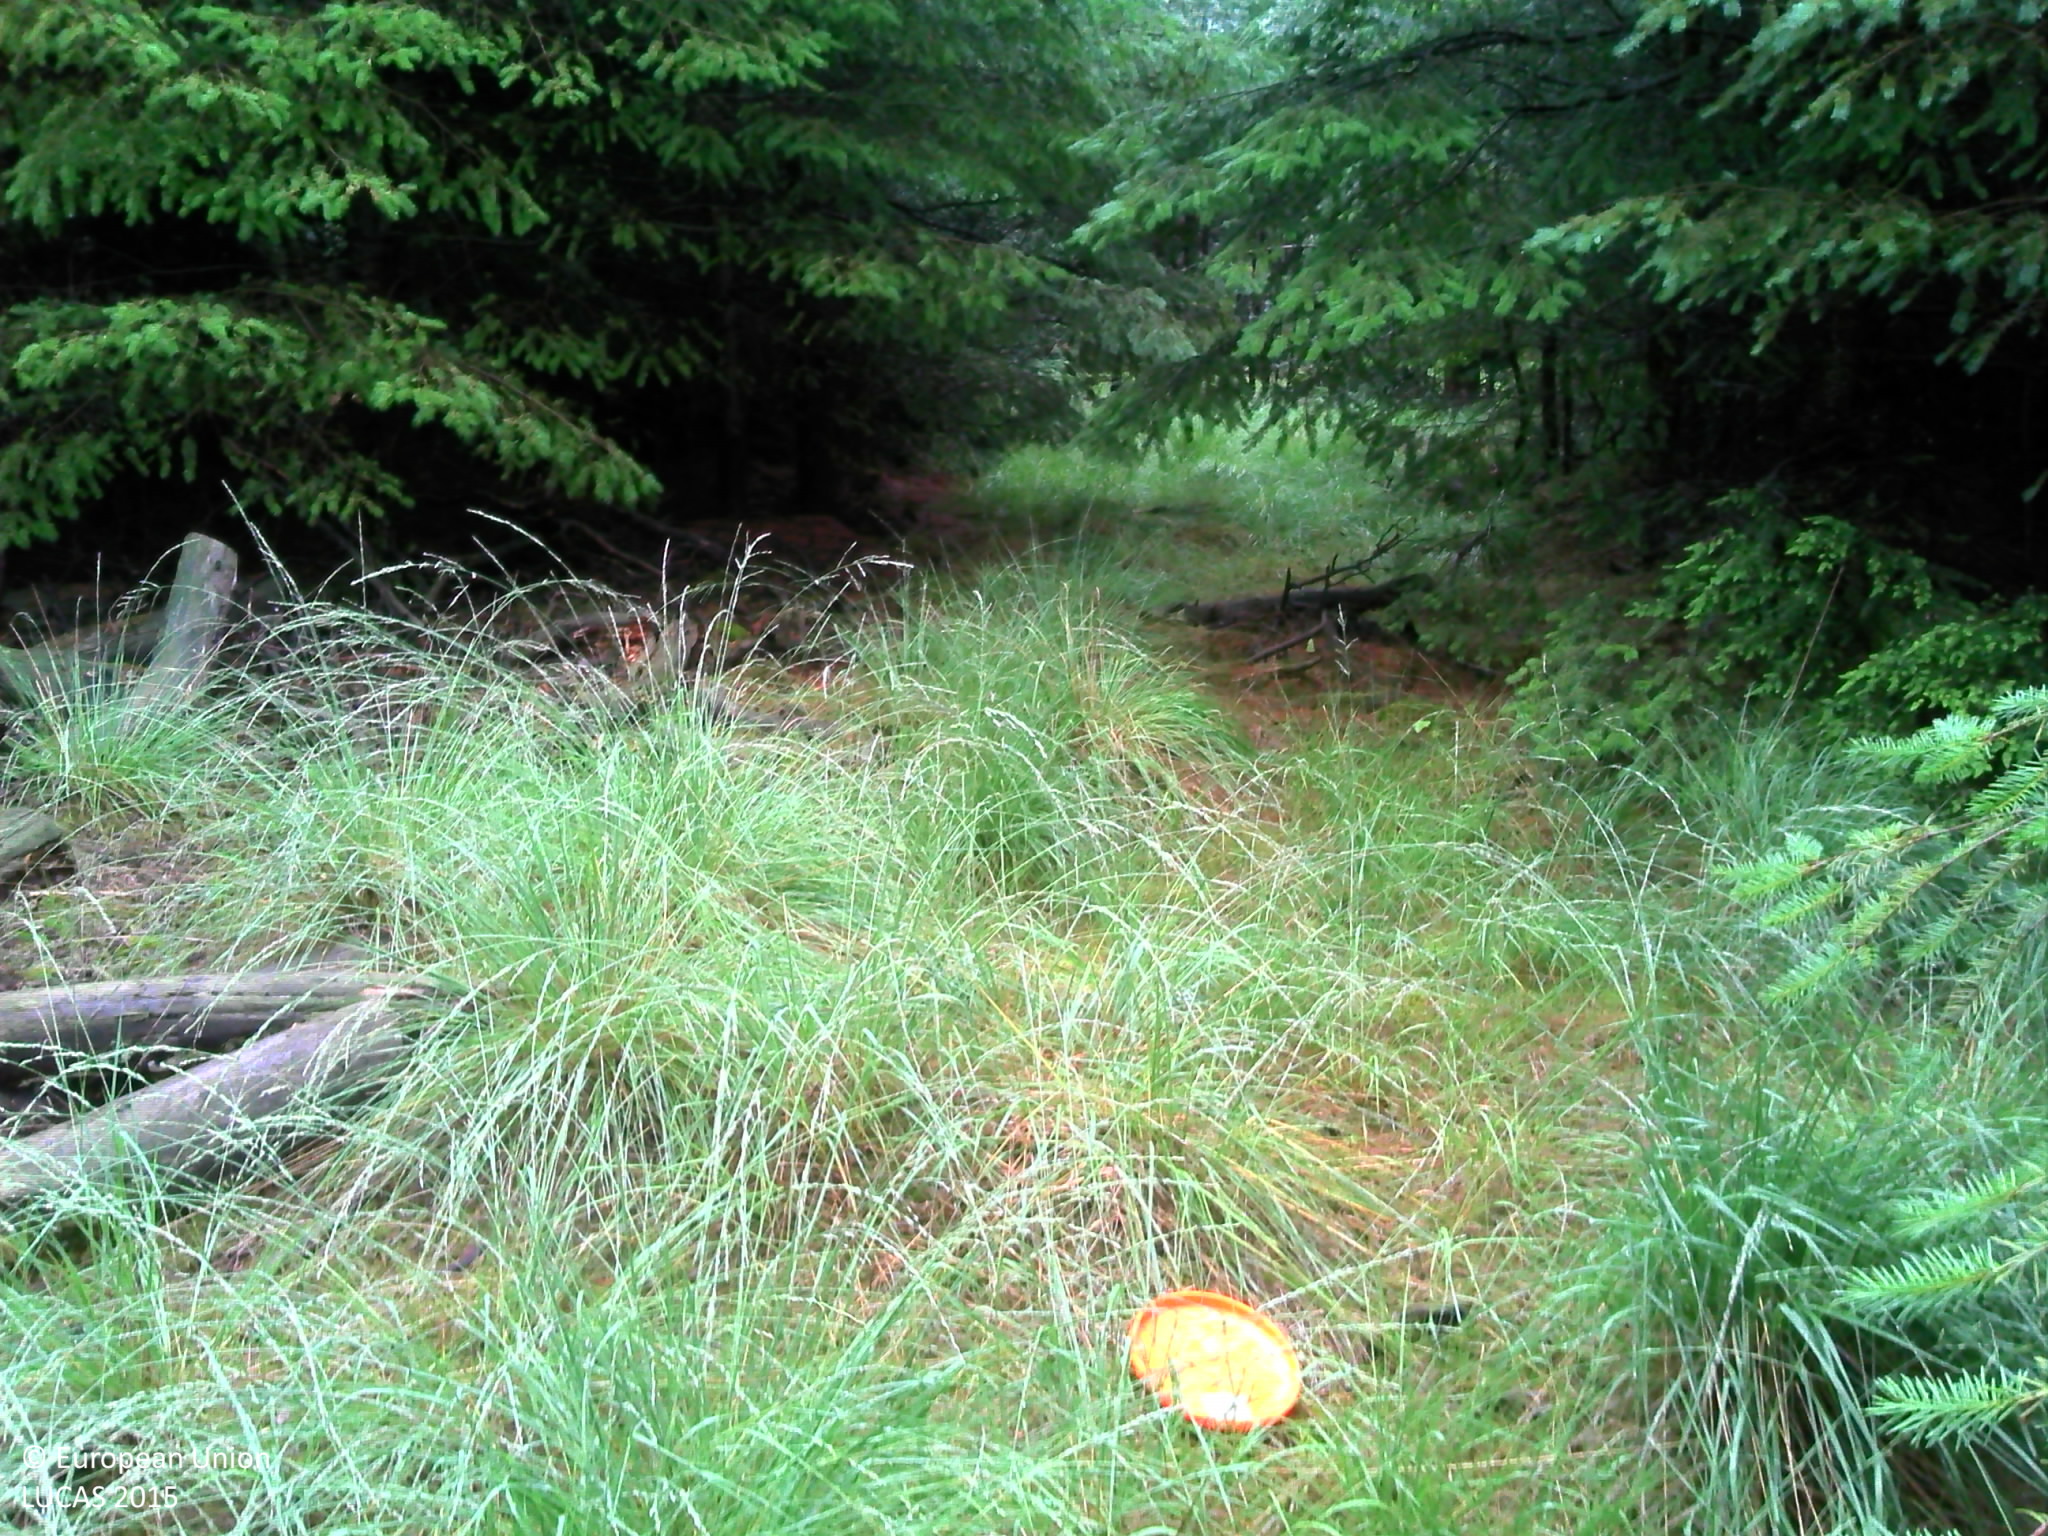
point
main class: Woodland
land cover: Other coniferous woodland
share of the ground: 50 - 75 %
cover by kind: coniferous forest trees 70 %, herbaceous plants 30 %
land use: Forestry
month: August
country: BE
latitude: 51.3579
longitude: 5.1003
